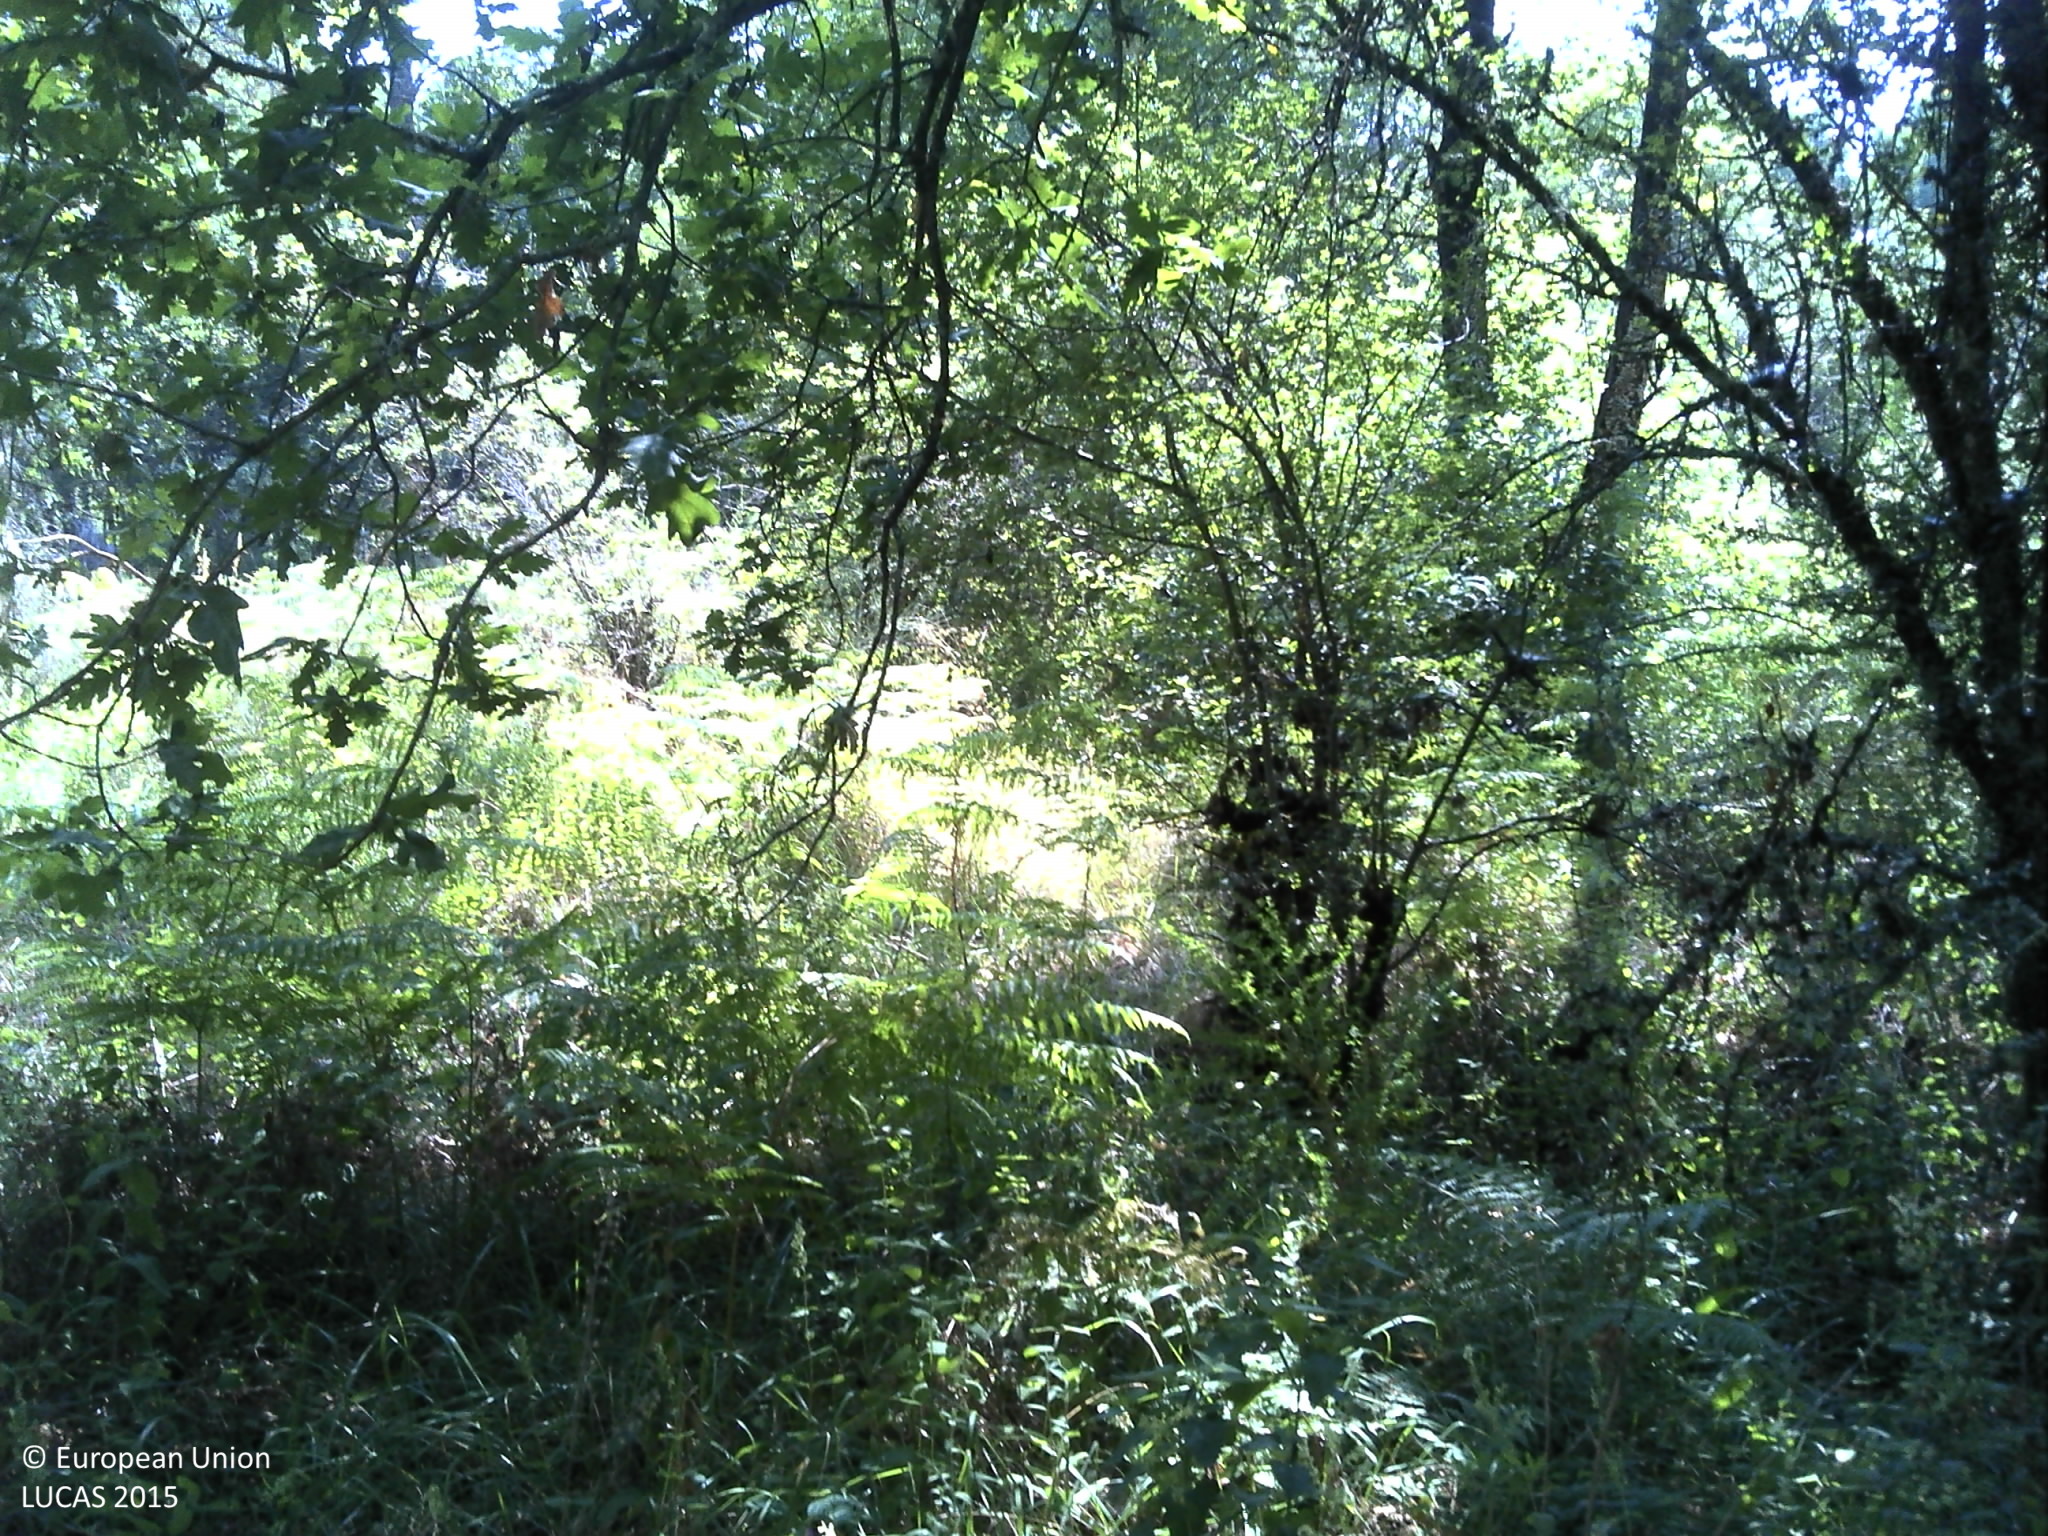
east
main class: Woodland
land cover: Broadleaved woodland
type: thermophilous deciduous forest
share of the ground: 10 - 25 %
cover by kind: shrubs 40 %, broadleaved forest trees 20 %, herbaceous plants 20 %, unconsolidated bare surface 20 %
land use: Forestry
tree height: > 5 m
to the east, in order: Broadleaved woodland; Shrubland with sparse tree cover
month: July
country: PT
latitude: 40.7566
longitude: -7.8566
